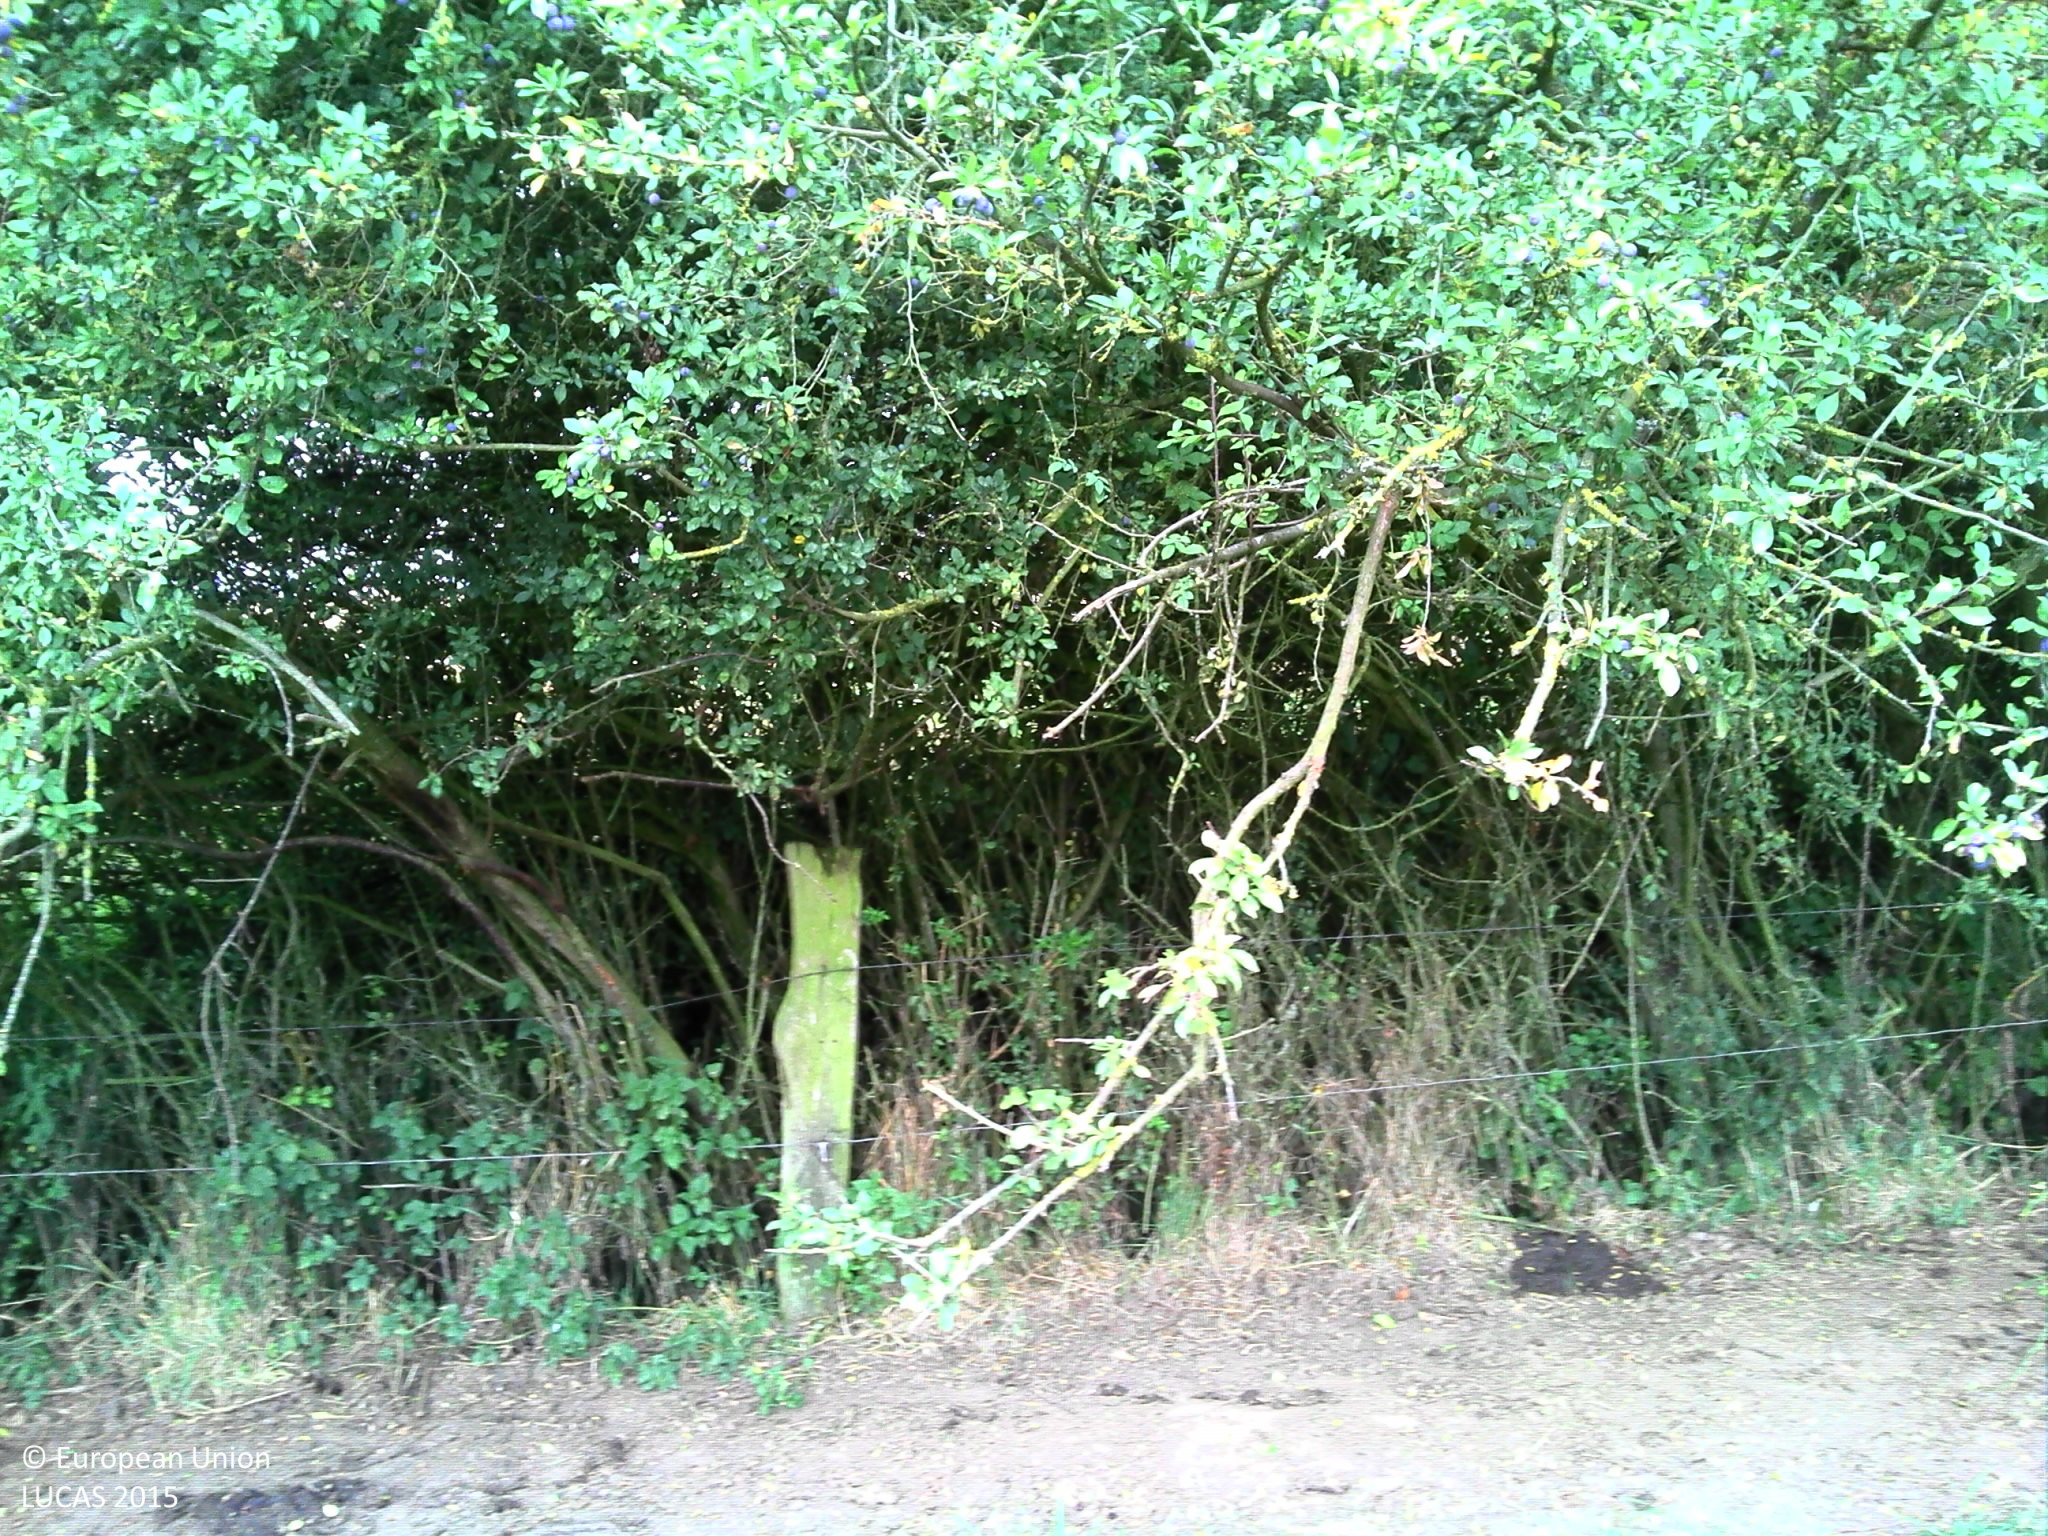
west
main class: Grassland
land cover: Grassland without tree/shrub cover
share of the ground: > 75 %
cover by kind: herbaceous plants 100 %
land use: Agriculture (excluding fallow land and kitchen gardens)
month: August
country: BE
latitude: 50.6817
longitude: 3.7803
